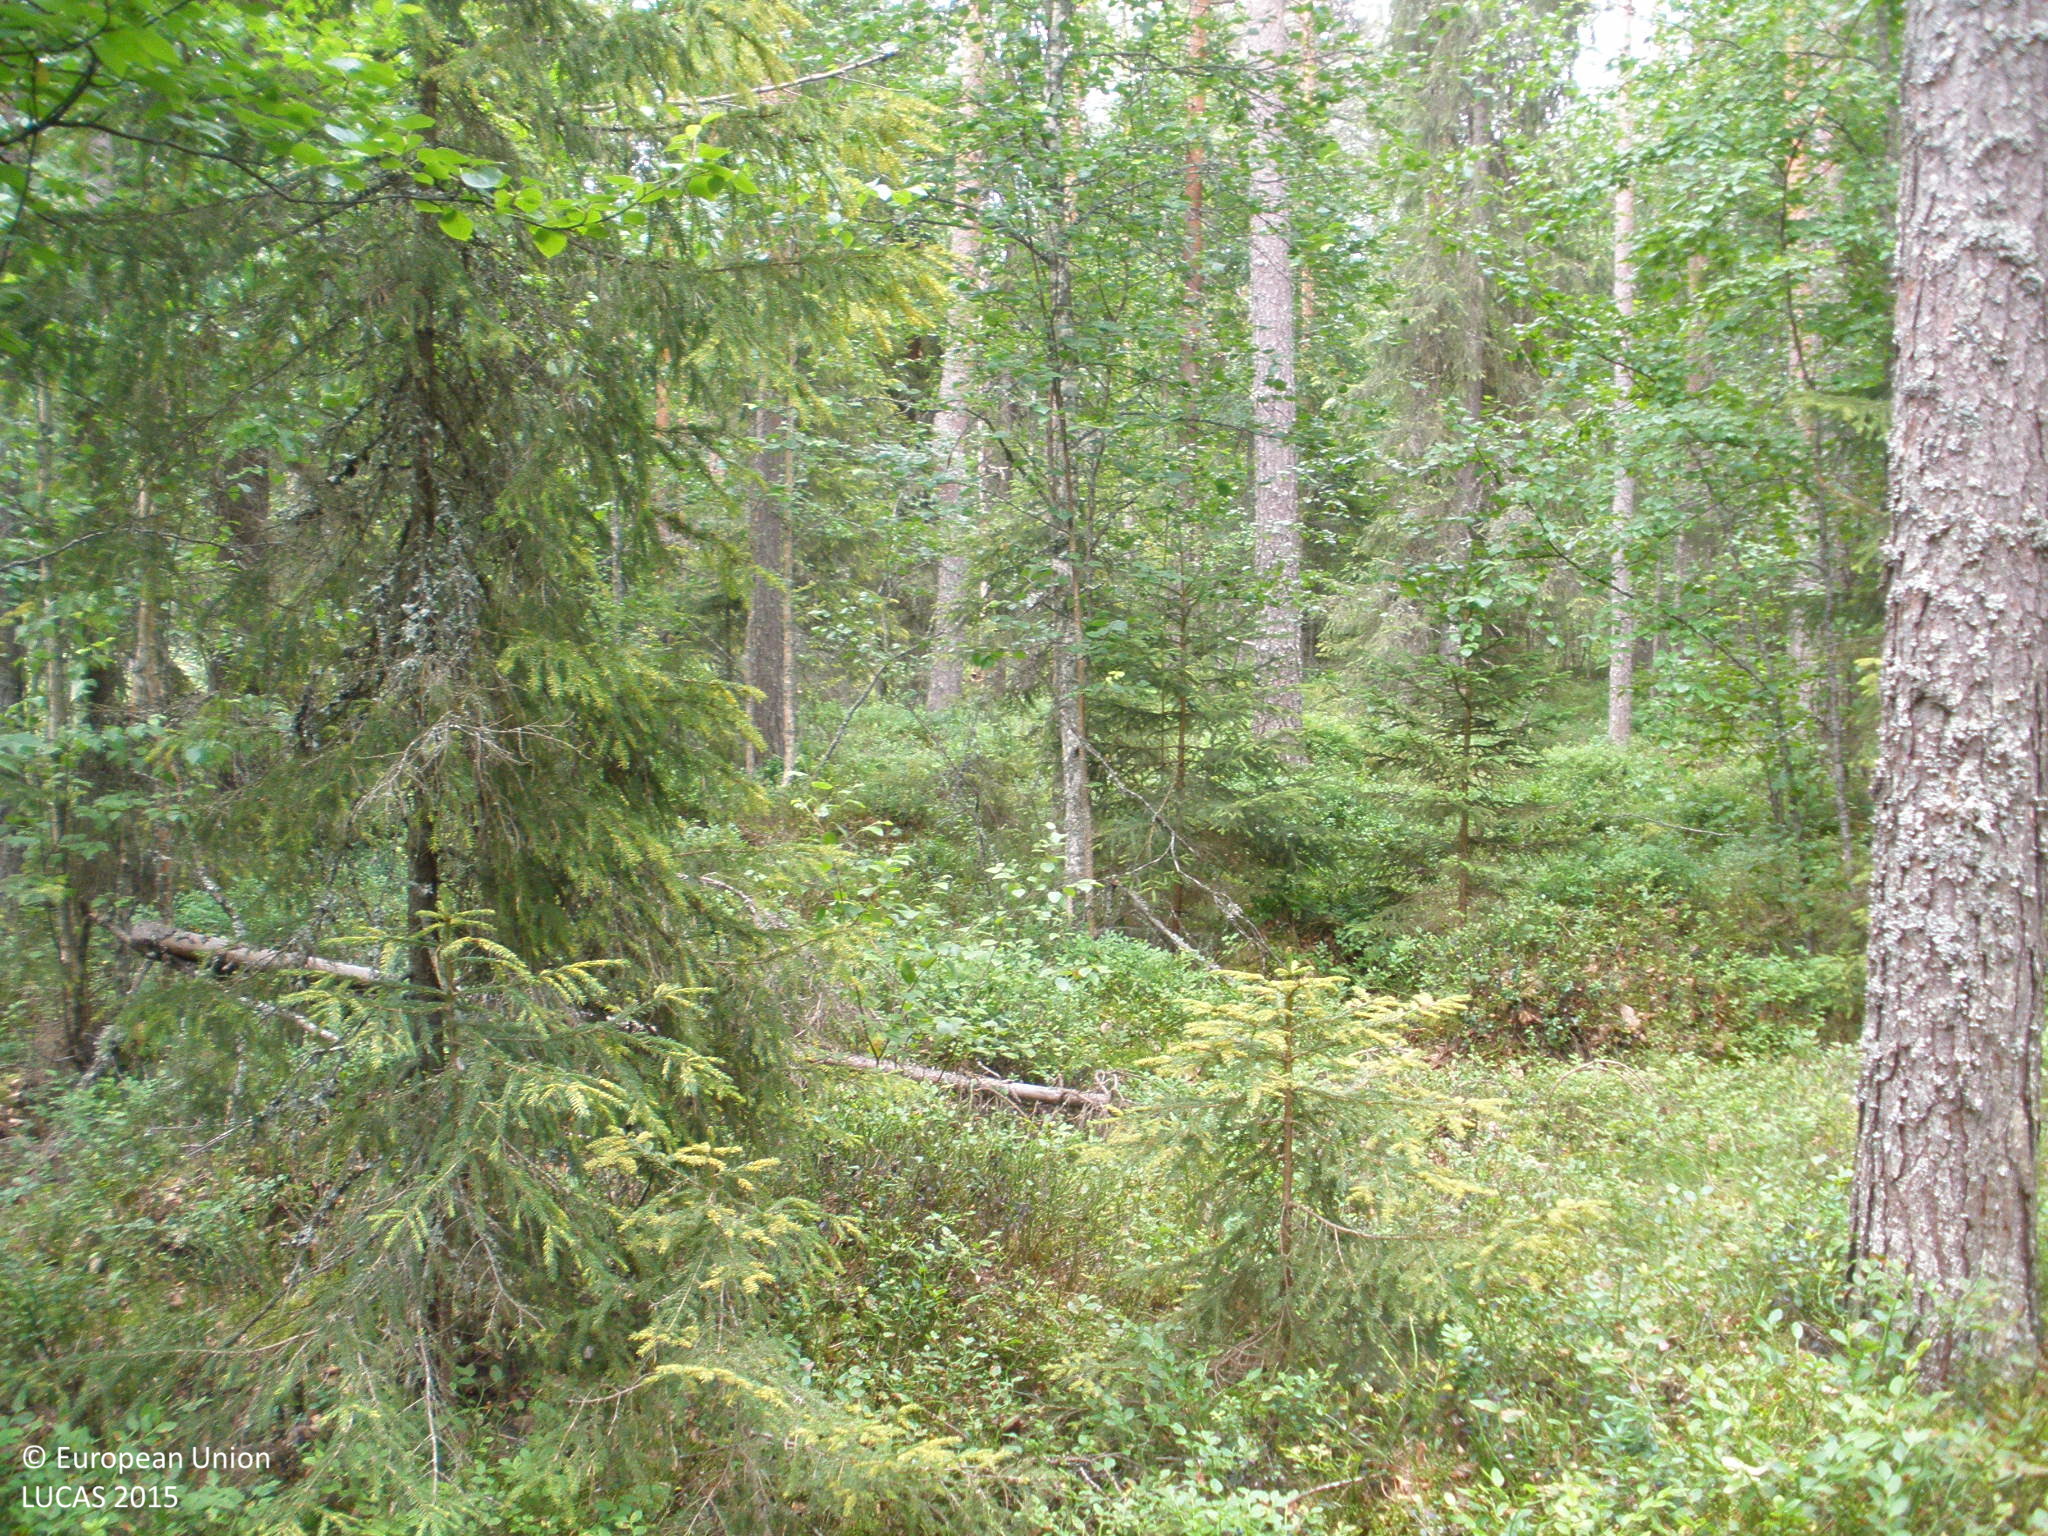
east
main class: Woodland
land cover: Pine dominated mixed woodland
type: boreal forest
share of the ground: > 75 %
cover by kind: coniferous forest trees 60 %, broadleaved forest trees 25 %, lichens and mosses 10 %, herbaceous plants 5 %
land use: Forestry
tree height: > 5 m
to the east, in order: Pine dominated mixed woodland; Broadleaved woodland; Ditches and canals; Spruce dominated mixed woodland
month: July
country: FI
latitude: 61.1676
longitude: 25.2302
